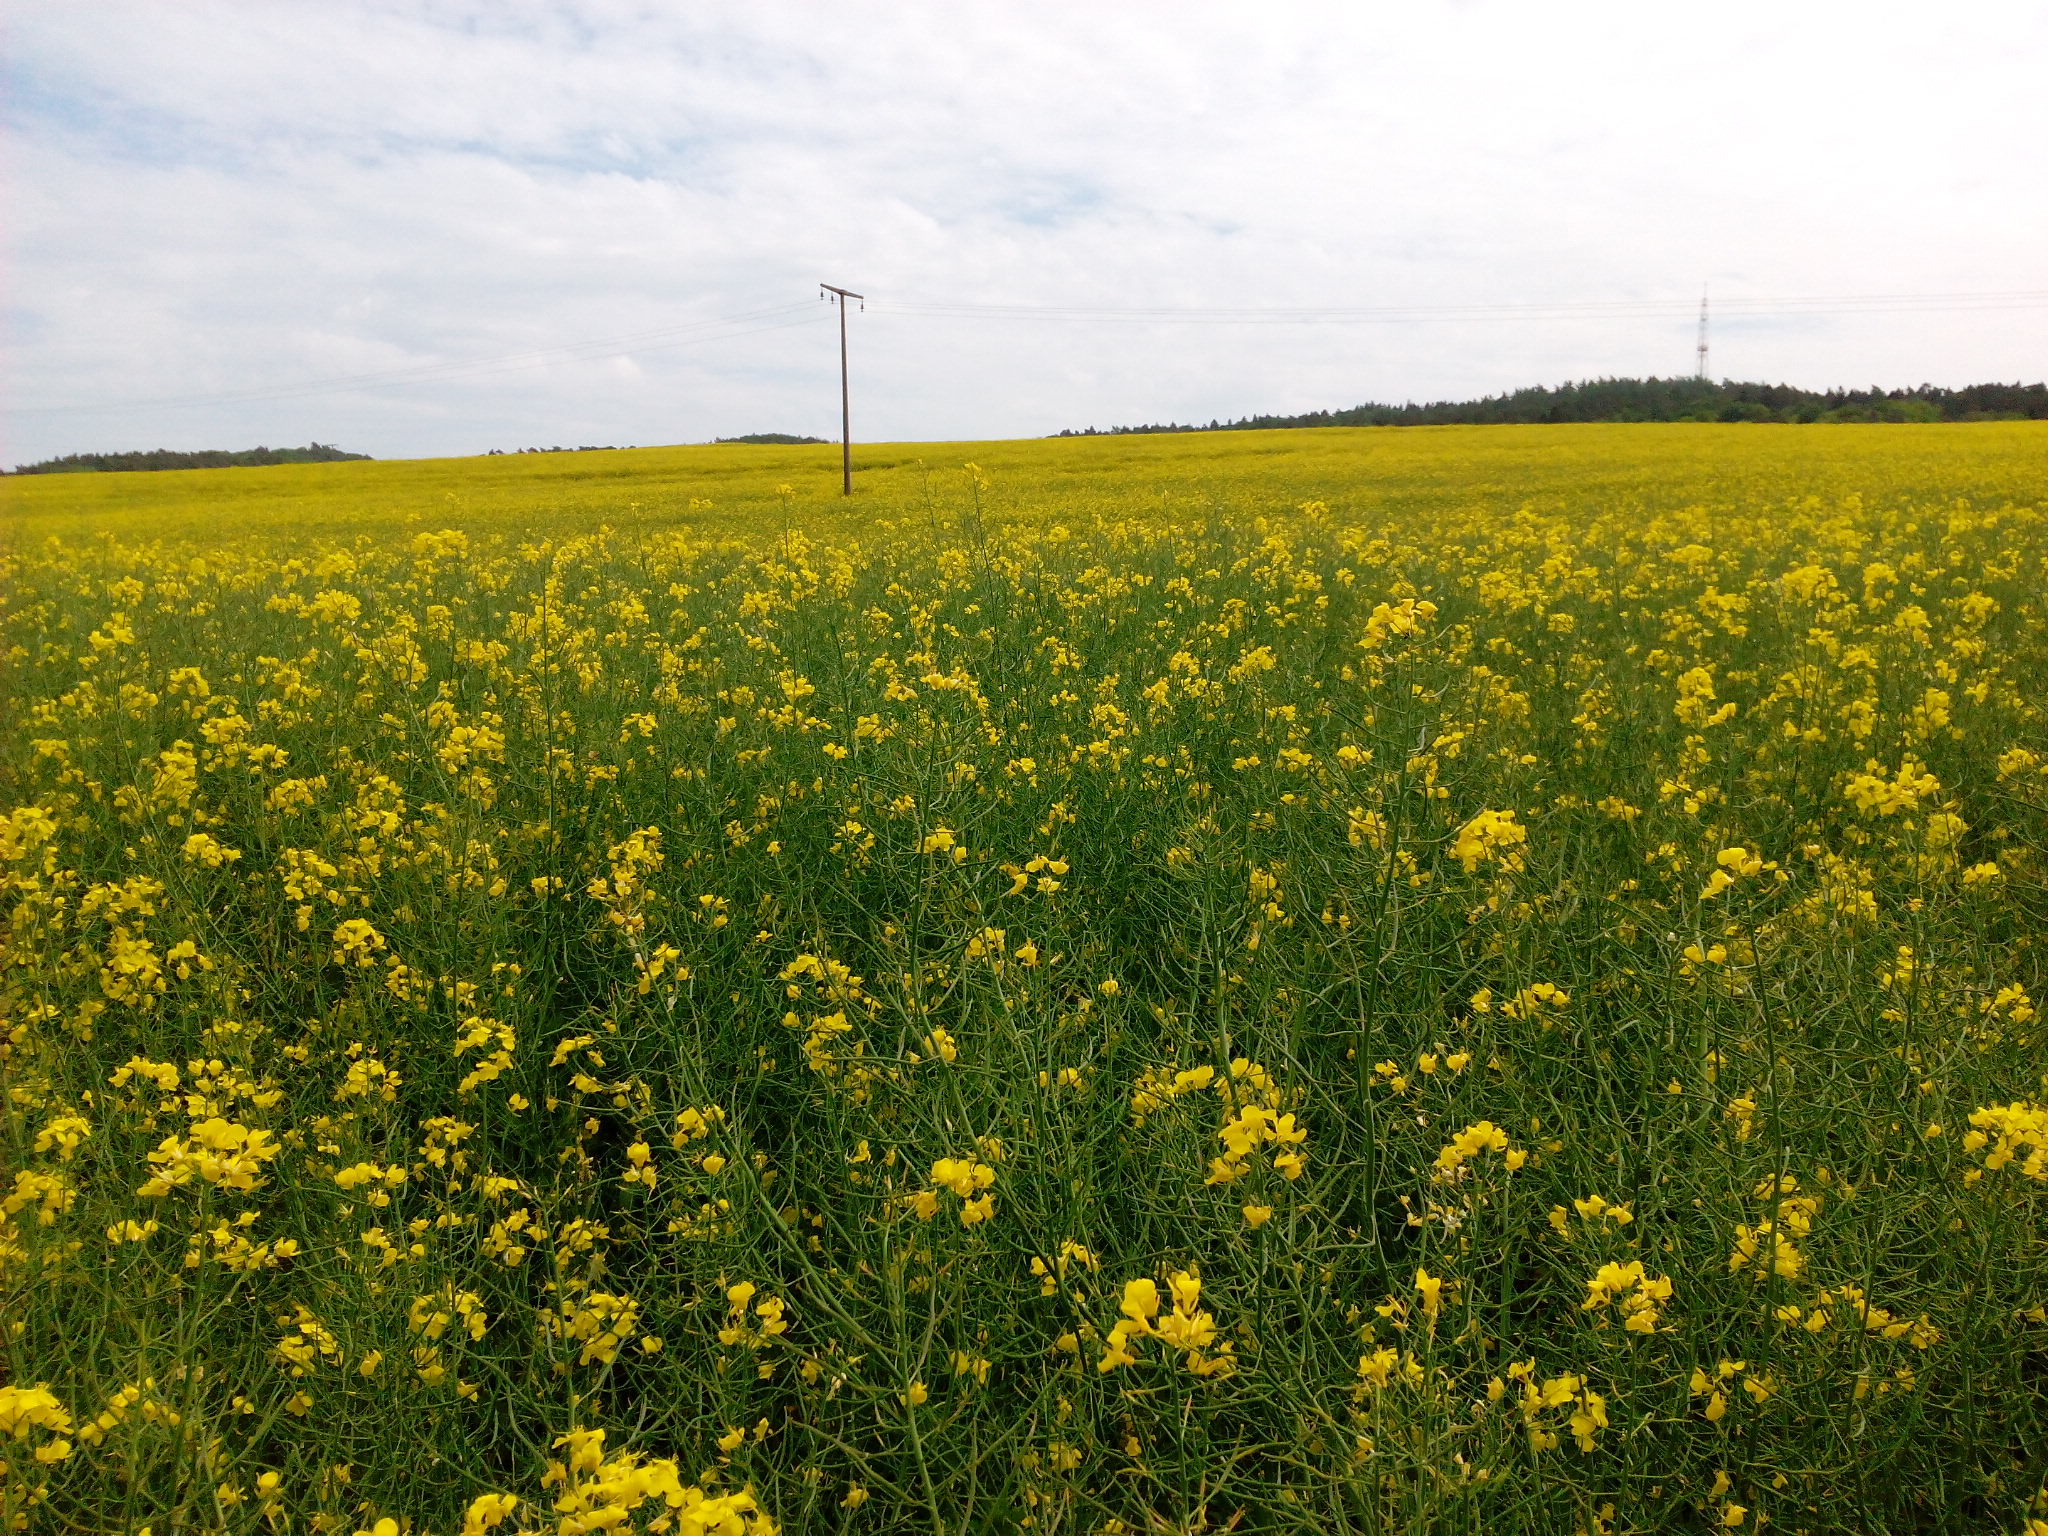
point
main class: Cropland
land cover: Rape and turnip rape
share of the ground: > 75 %
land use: Agriculture (excluding fallow land and kitchen gardens)
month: May
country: DE
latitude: 53.8038
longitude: 12.6868
